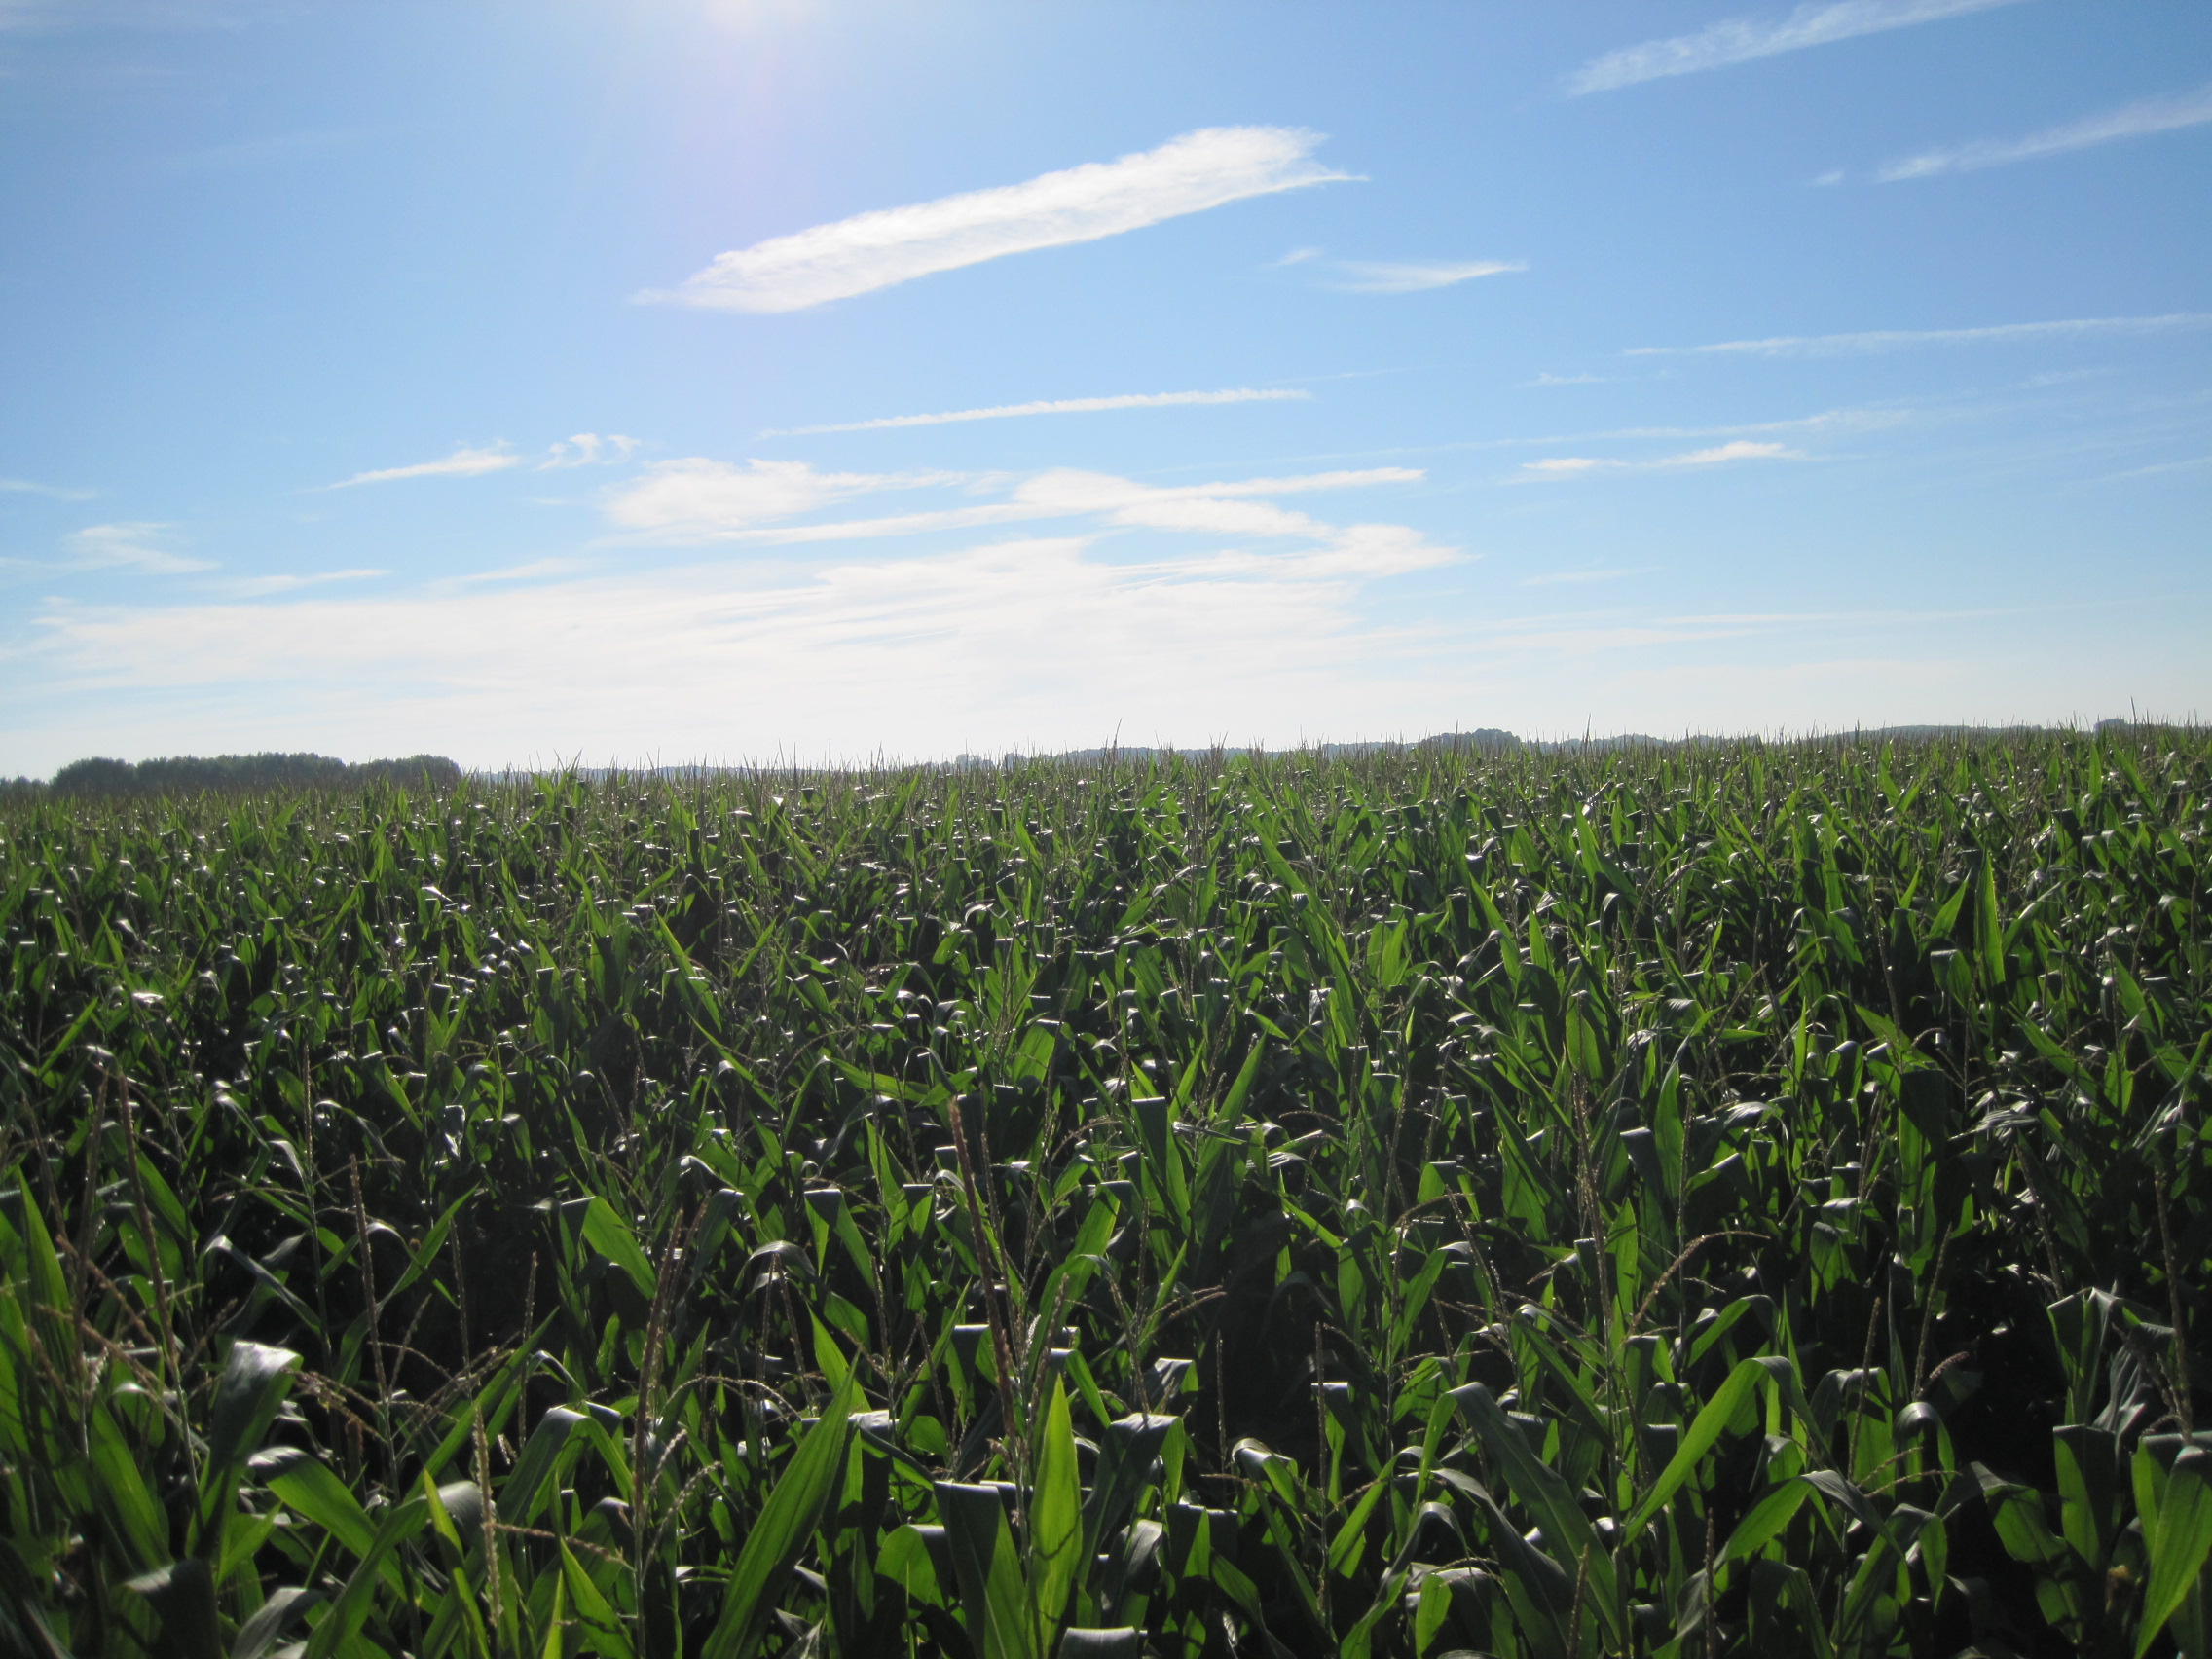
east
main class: Cropland
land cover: Maize
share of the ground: > 75 %
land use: Agriculture (excluding fallow land and kitchen gardens)
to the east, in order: Maize; Spontaneously vegetated surfaces; Tracks; Grassland without tree/shrub cover; Ditches and canals; Grassland without tree/shrub cover; Maize
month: July
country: ES
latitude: 42.0189
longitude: -5.6334
